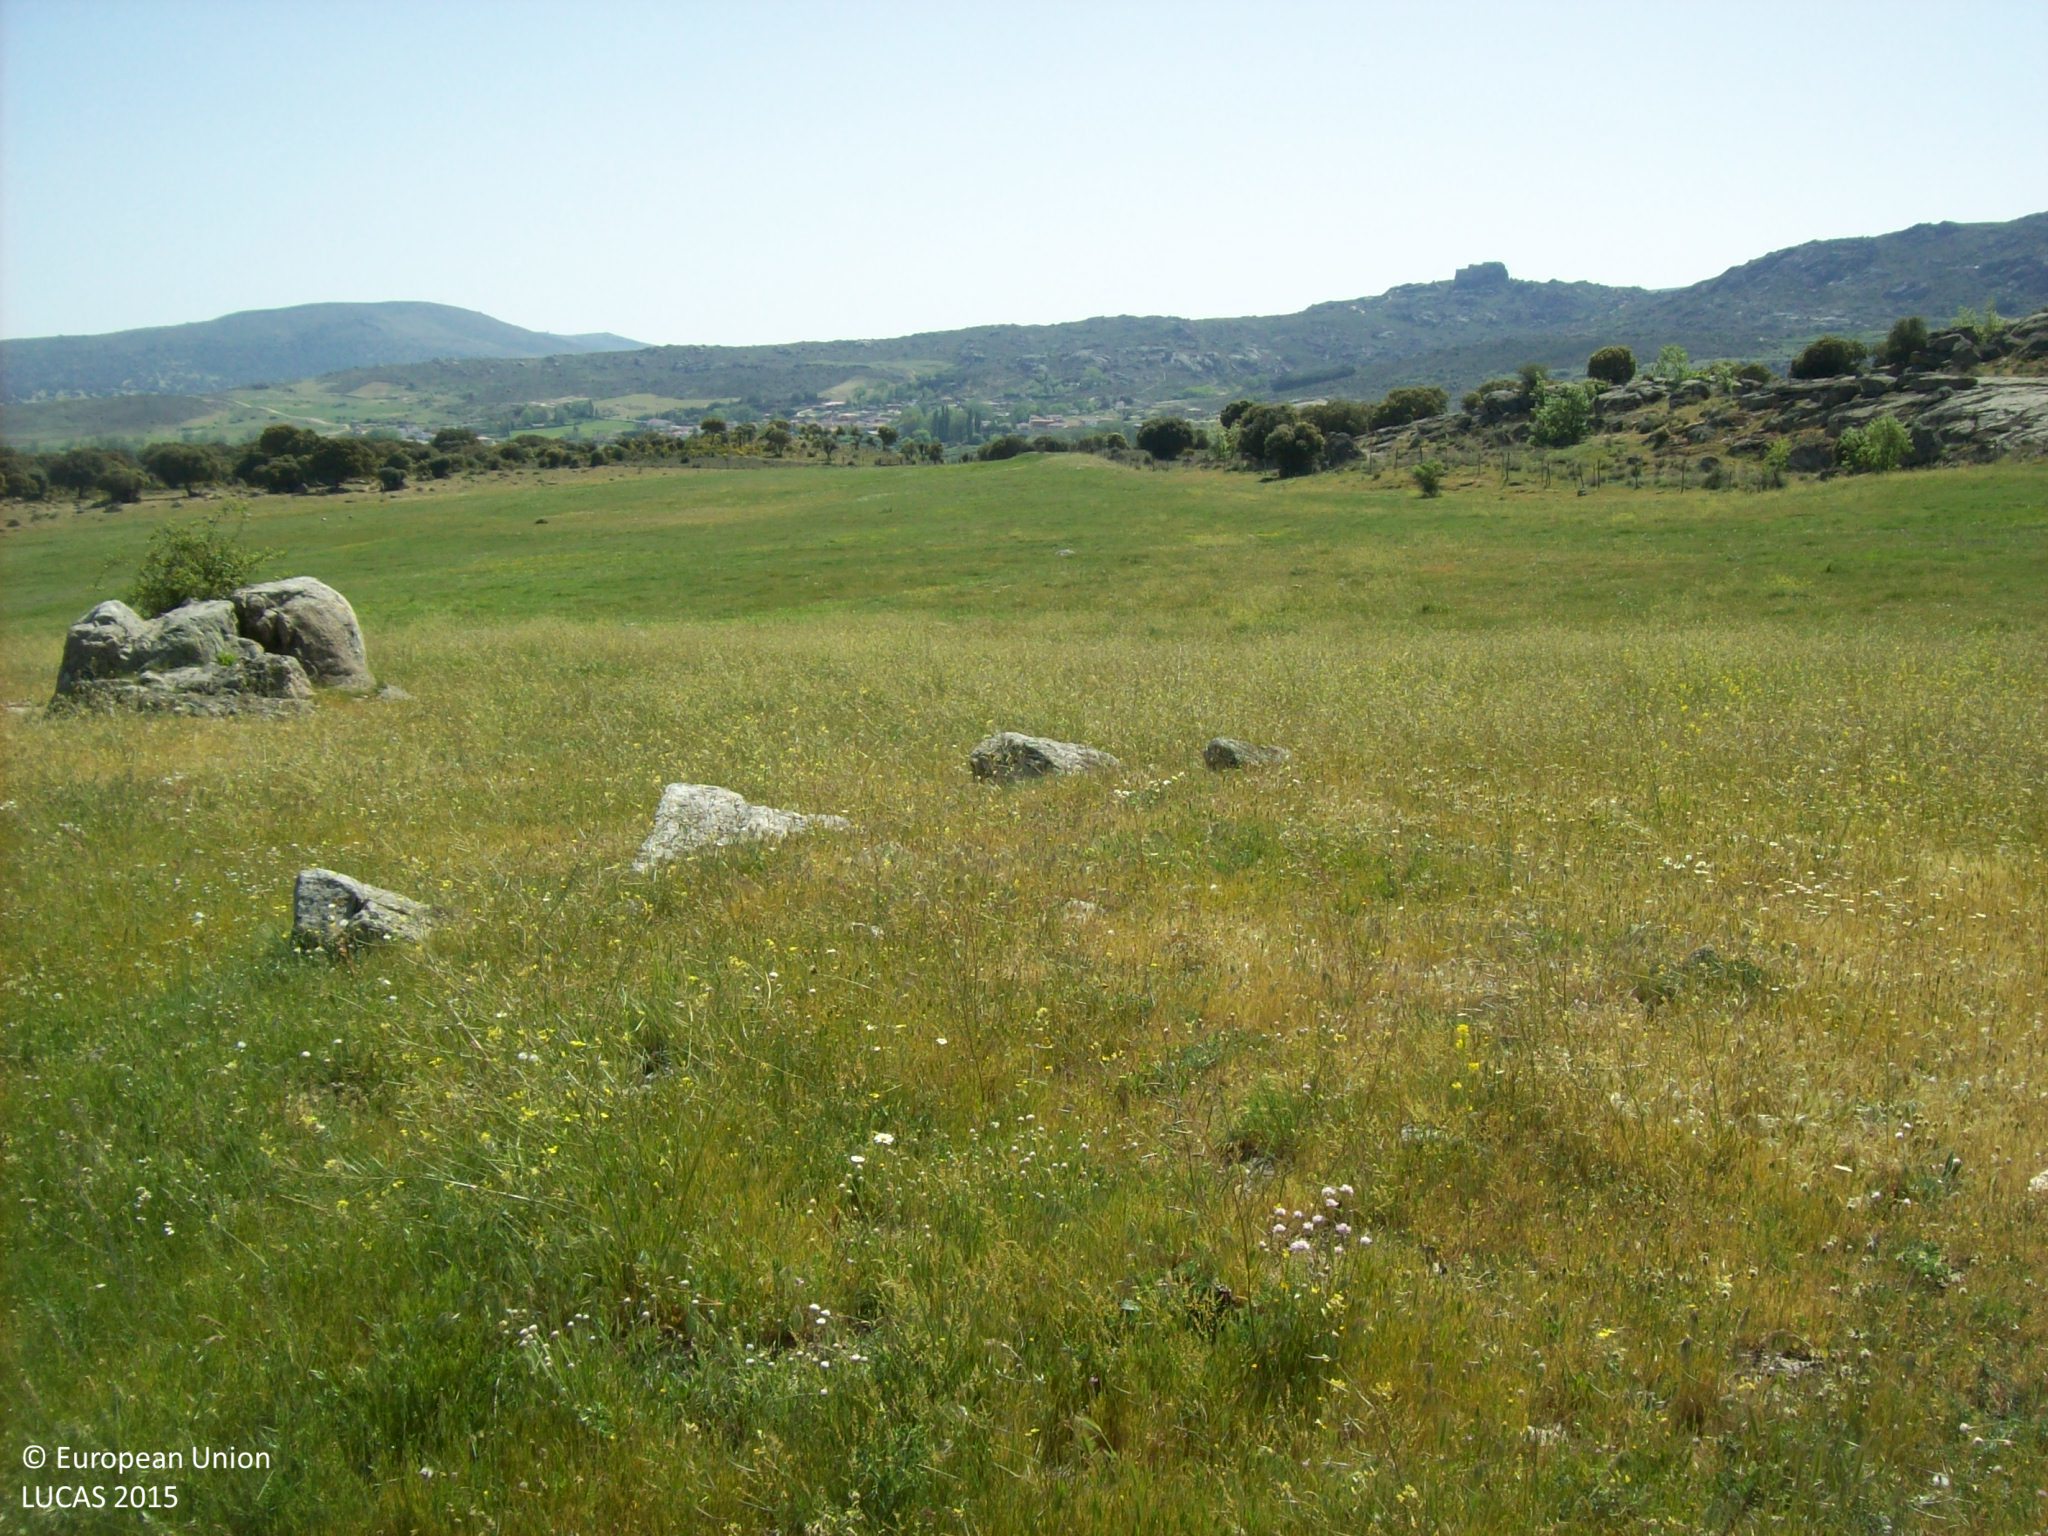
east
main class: Grassland
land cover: Grassland without tree/shrub cover
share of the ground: > 75 %
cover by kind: herbaceous plants 95 %, shrubs 5 %
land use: Agriculture (excluding fallow land and kitchen gardens)
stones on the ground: < 10 %
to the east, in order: Grassland without tree/shrub cover
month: May
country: ES
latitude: 40.5399
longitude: -4.8743
